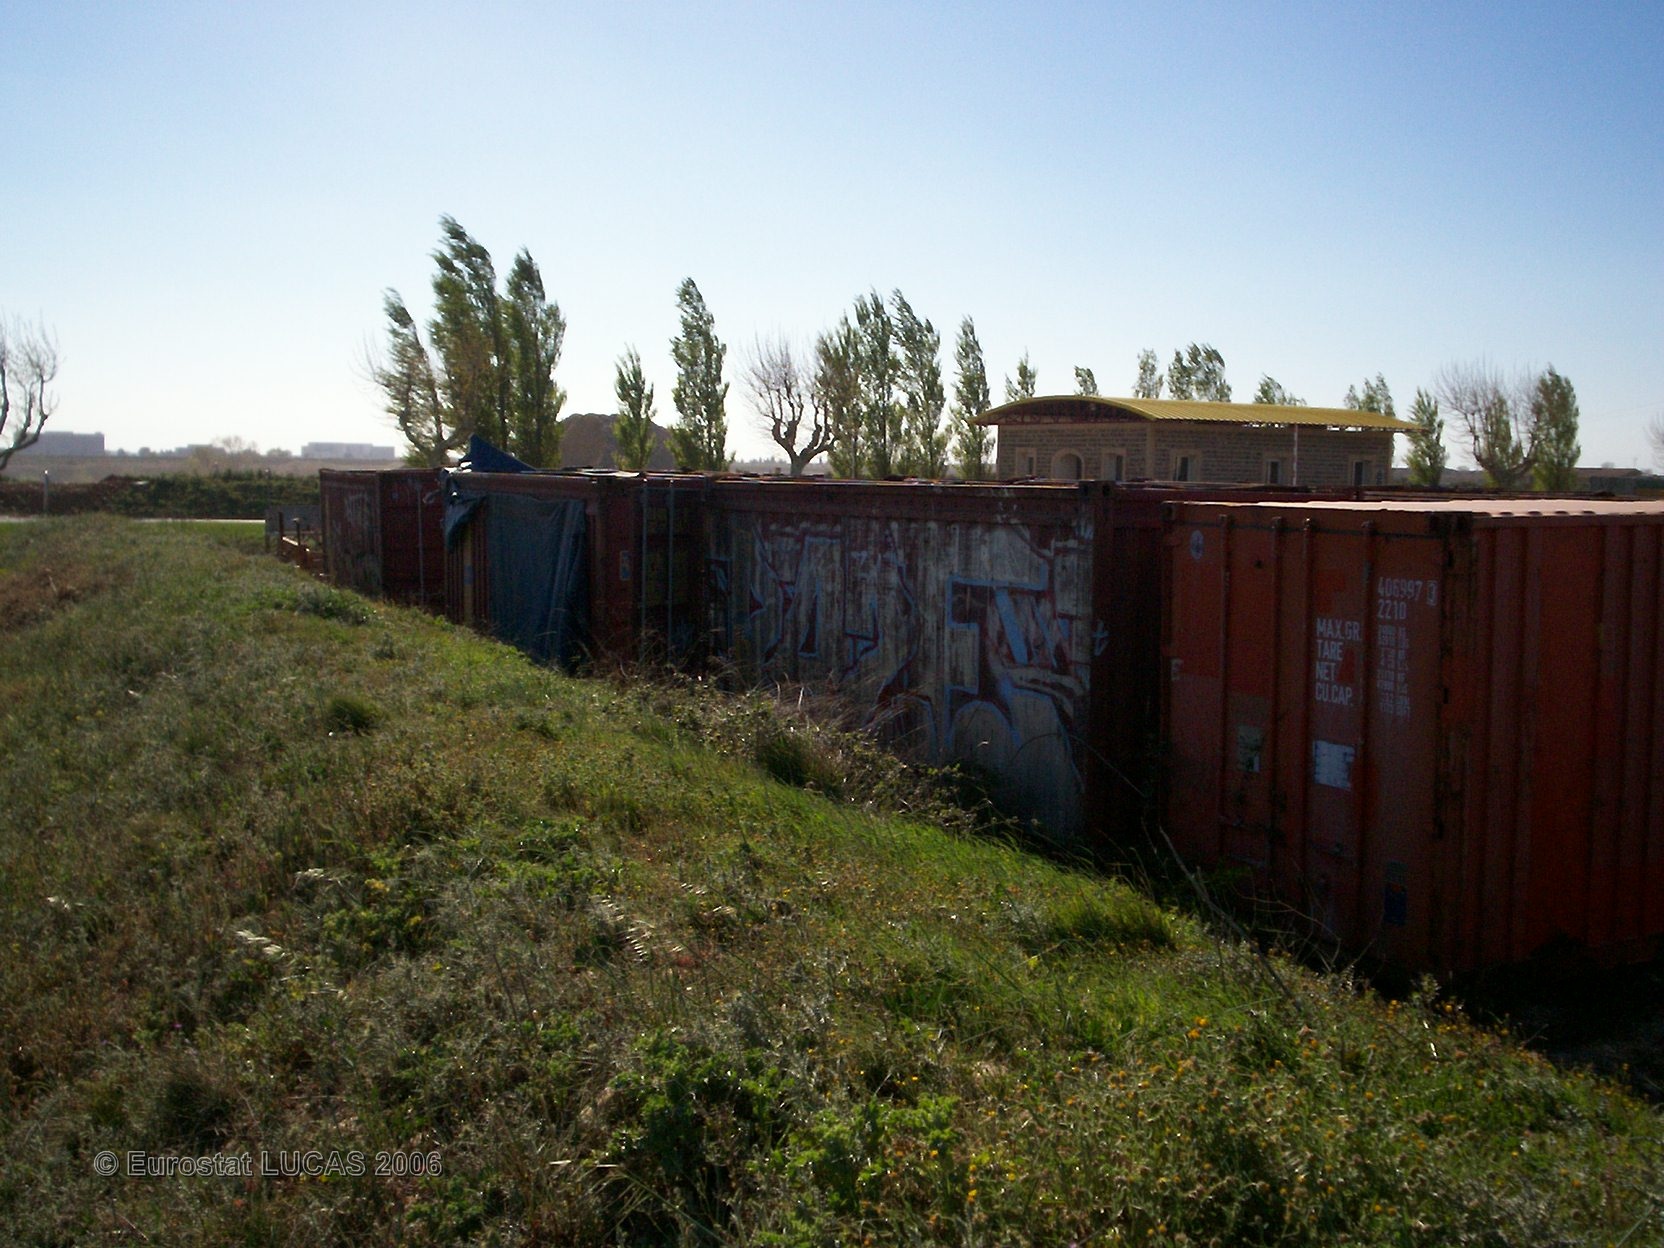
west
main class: Artificial land
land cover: Non built-up area features
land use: Logistics and storage
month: April
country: FR
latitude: 43.5408
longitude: 4.9481
